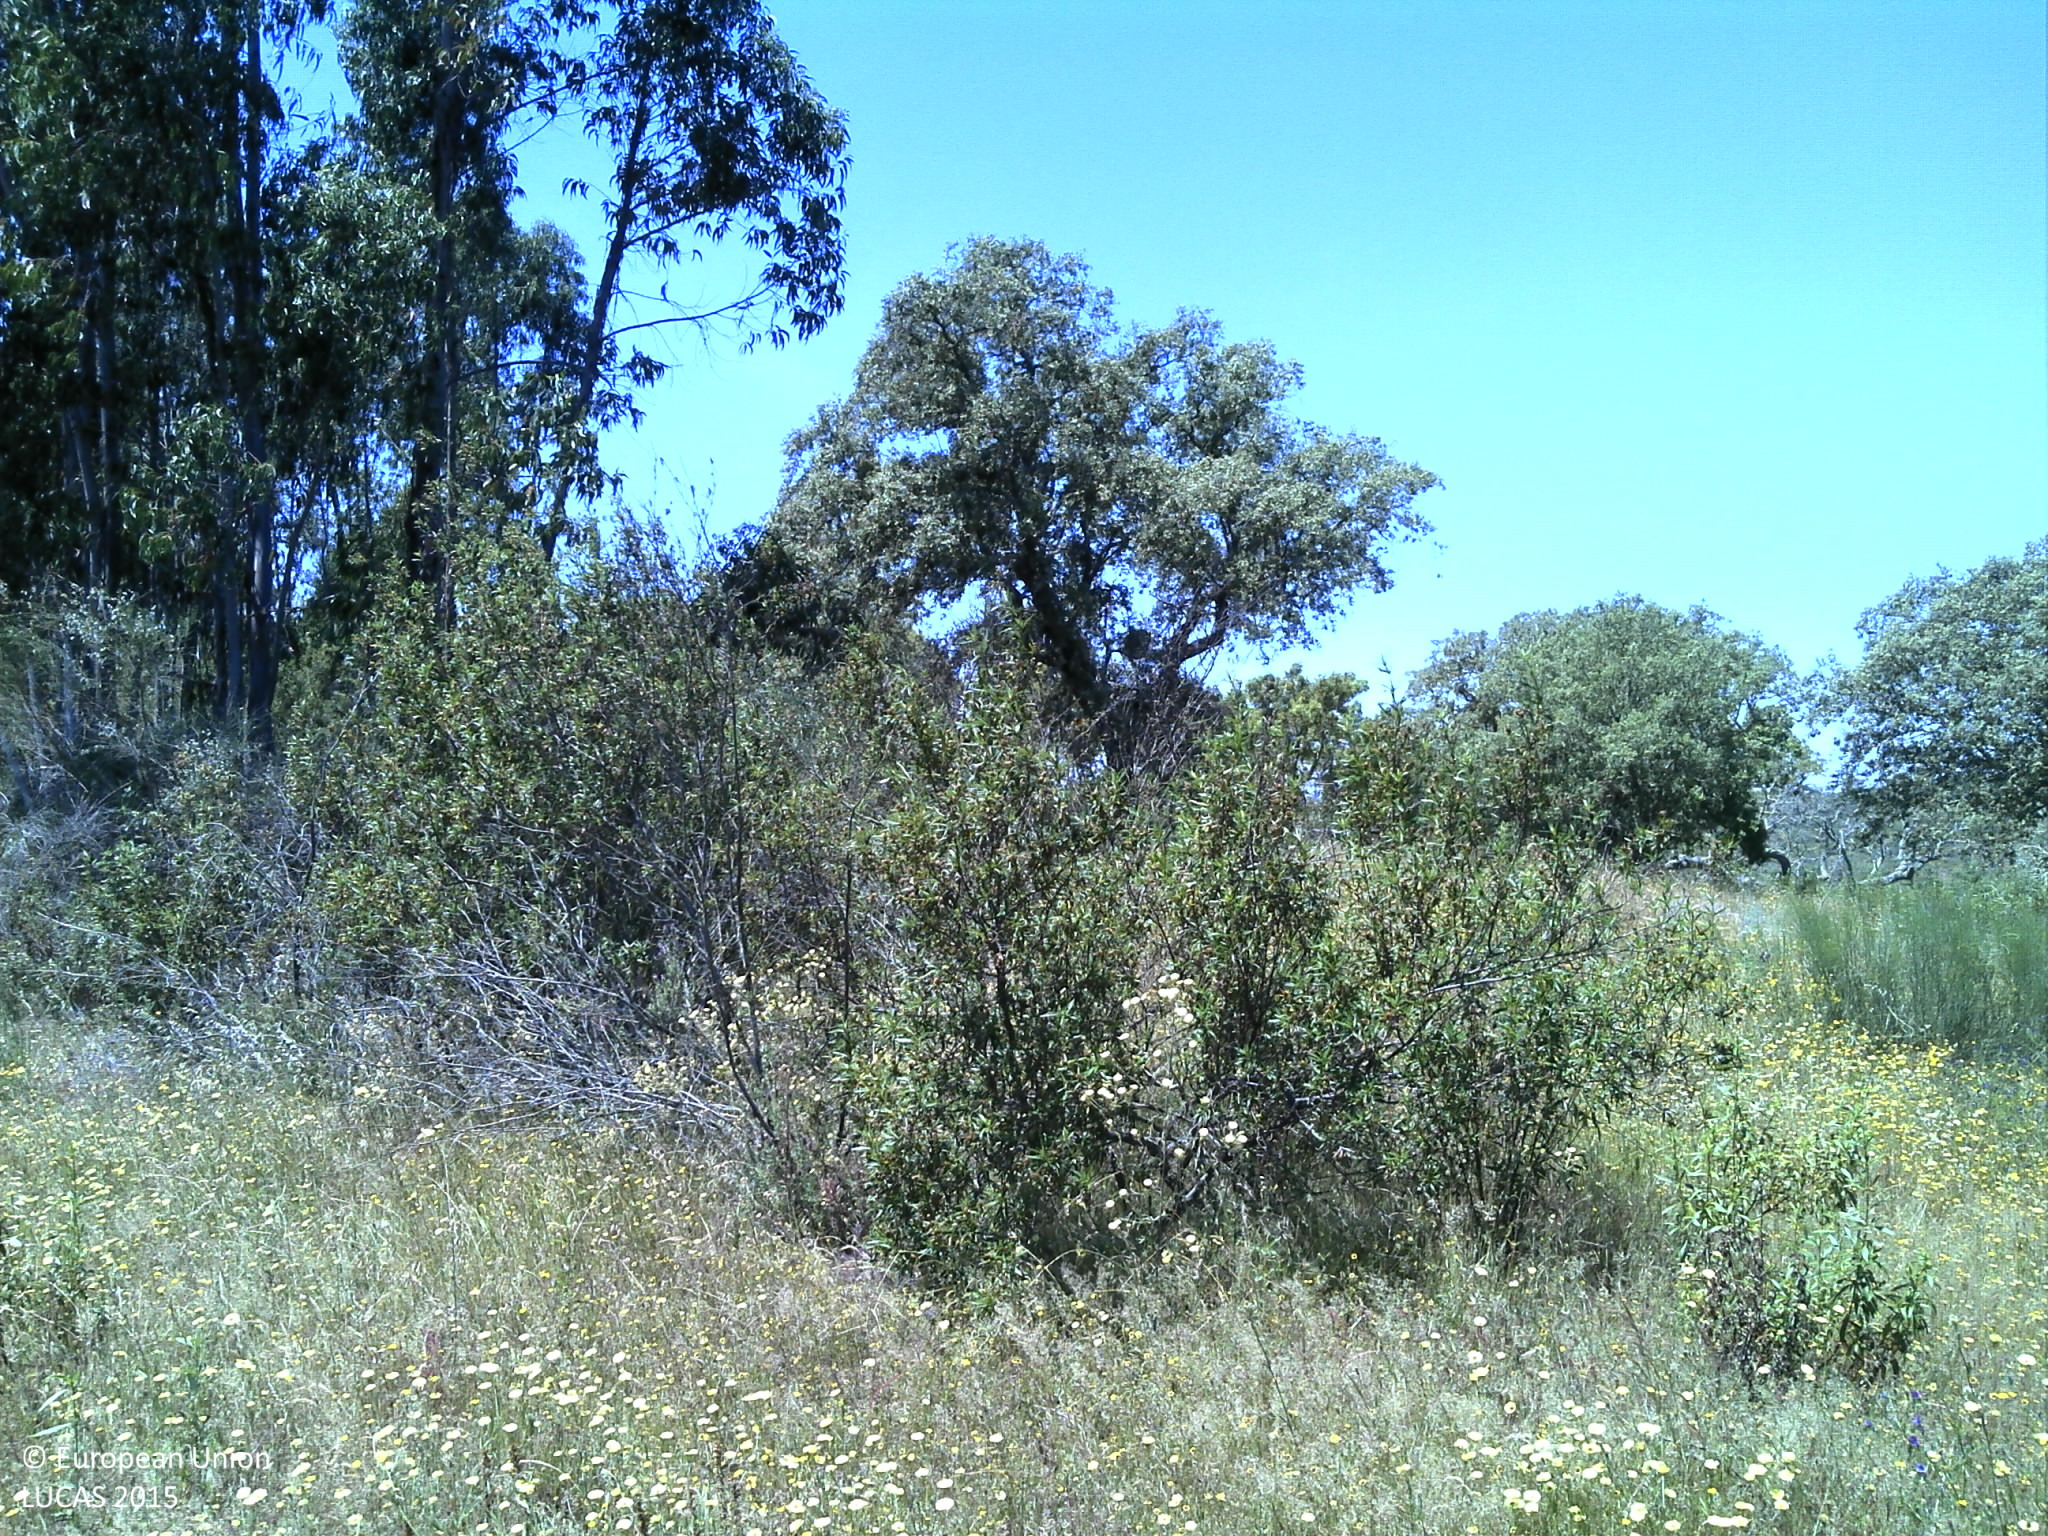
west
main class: Woodland
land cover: Broadleaved woodland
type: broadleaved evergreen forest
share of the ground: 10 - 25 %
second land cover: Grassland without tree/shrub cover
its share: 25 - 50 %
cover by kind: broadleaved forest trees 25 %, shrubs 25 %, herbaceous plants 25 %, unconsolidated bare surface 25 %
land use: Forestry
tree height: > 5 m
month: May
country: PT
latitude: 39.2068
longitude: -7.8492
